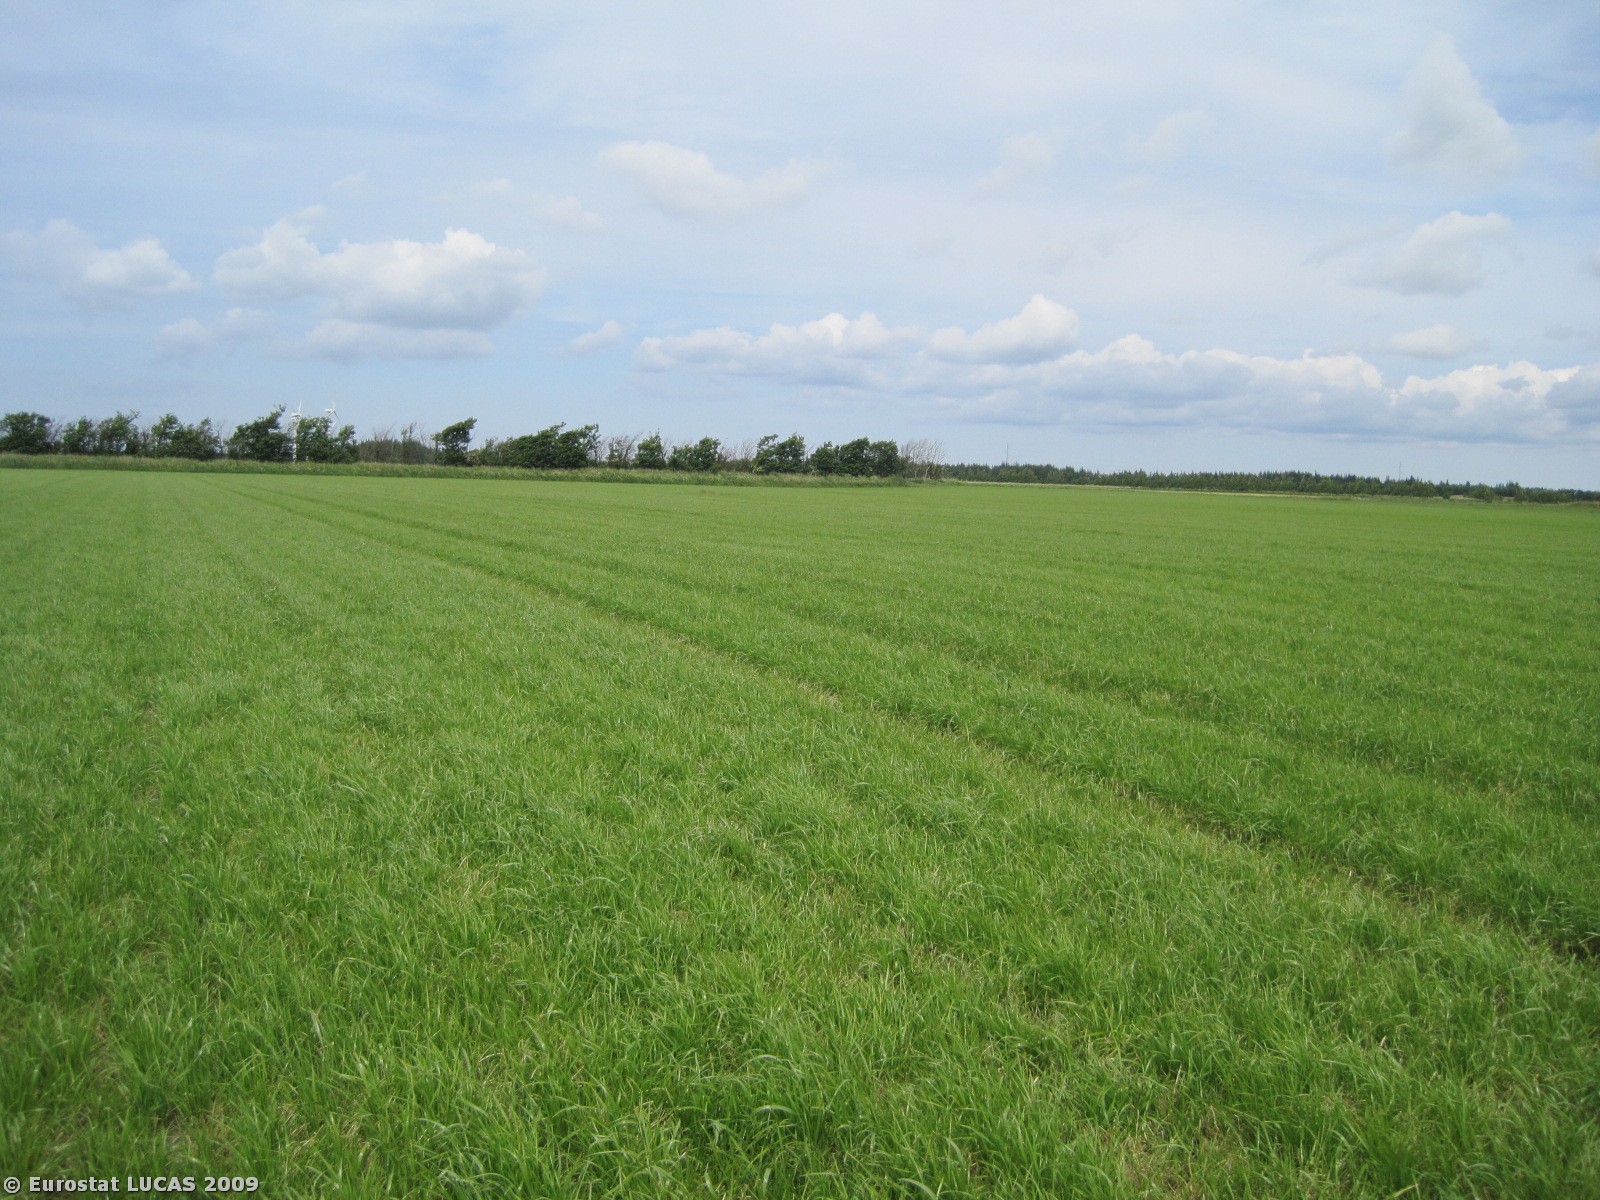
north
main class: Cropland
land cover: Temporary grasslands
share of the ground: > 75 %
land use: Agriculture (excluding fallow land and kitchen gardens)
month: June
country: DK
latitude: 57.3201
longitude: 9.7513
